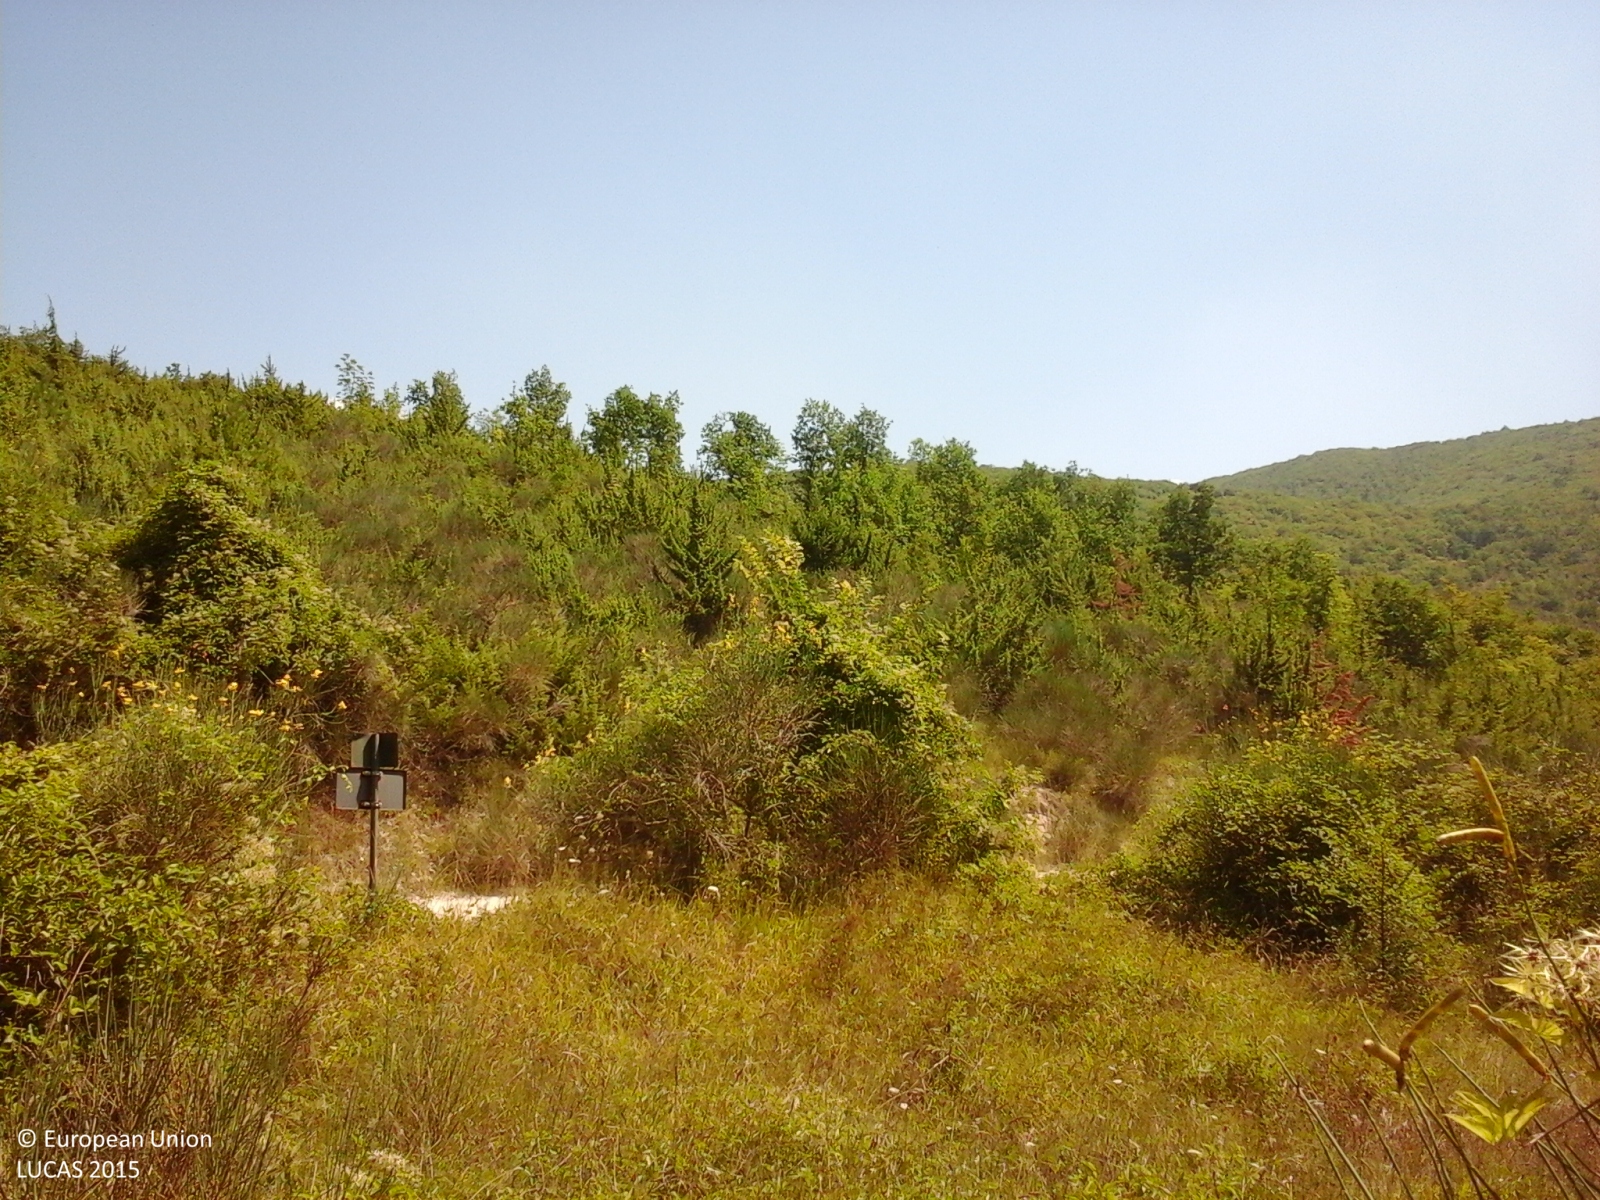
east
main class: Woodland
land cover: Broadleaved woodland
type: thermophilous deciduous forest
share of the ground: > 75 %
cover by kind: broadleaved forest trees 95 %, coniferous forest trees 5 %
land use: Forestry
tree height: > 5 m
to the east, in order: Broadleaved woodland; Tracks; Broadleaved woodland; Shrubland without tree cover; Paved roads, cycling and walking lanes; Shrubland without tree cover; Broadleaved woodland
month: August
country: IT
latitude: 43.3259
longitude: 13.2103
